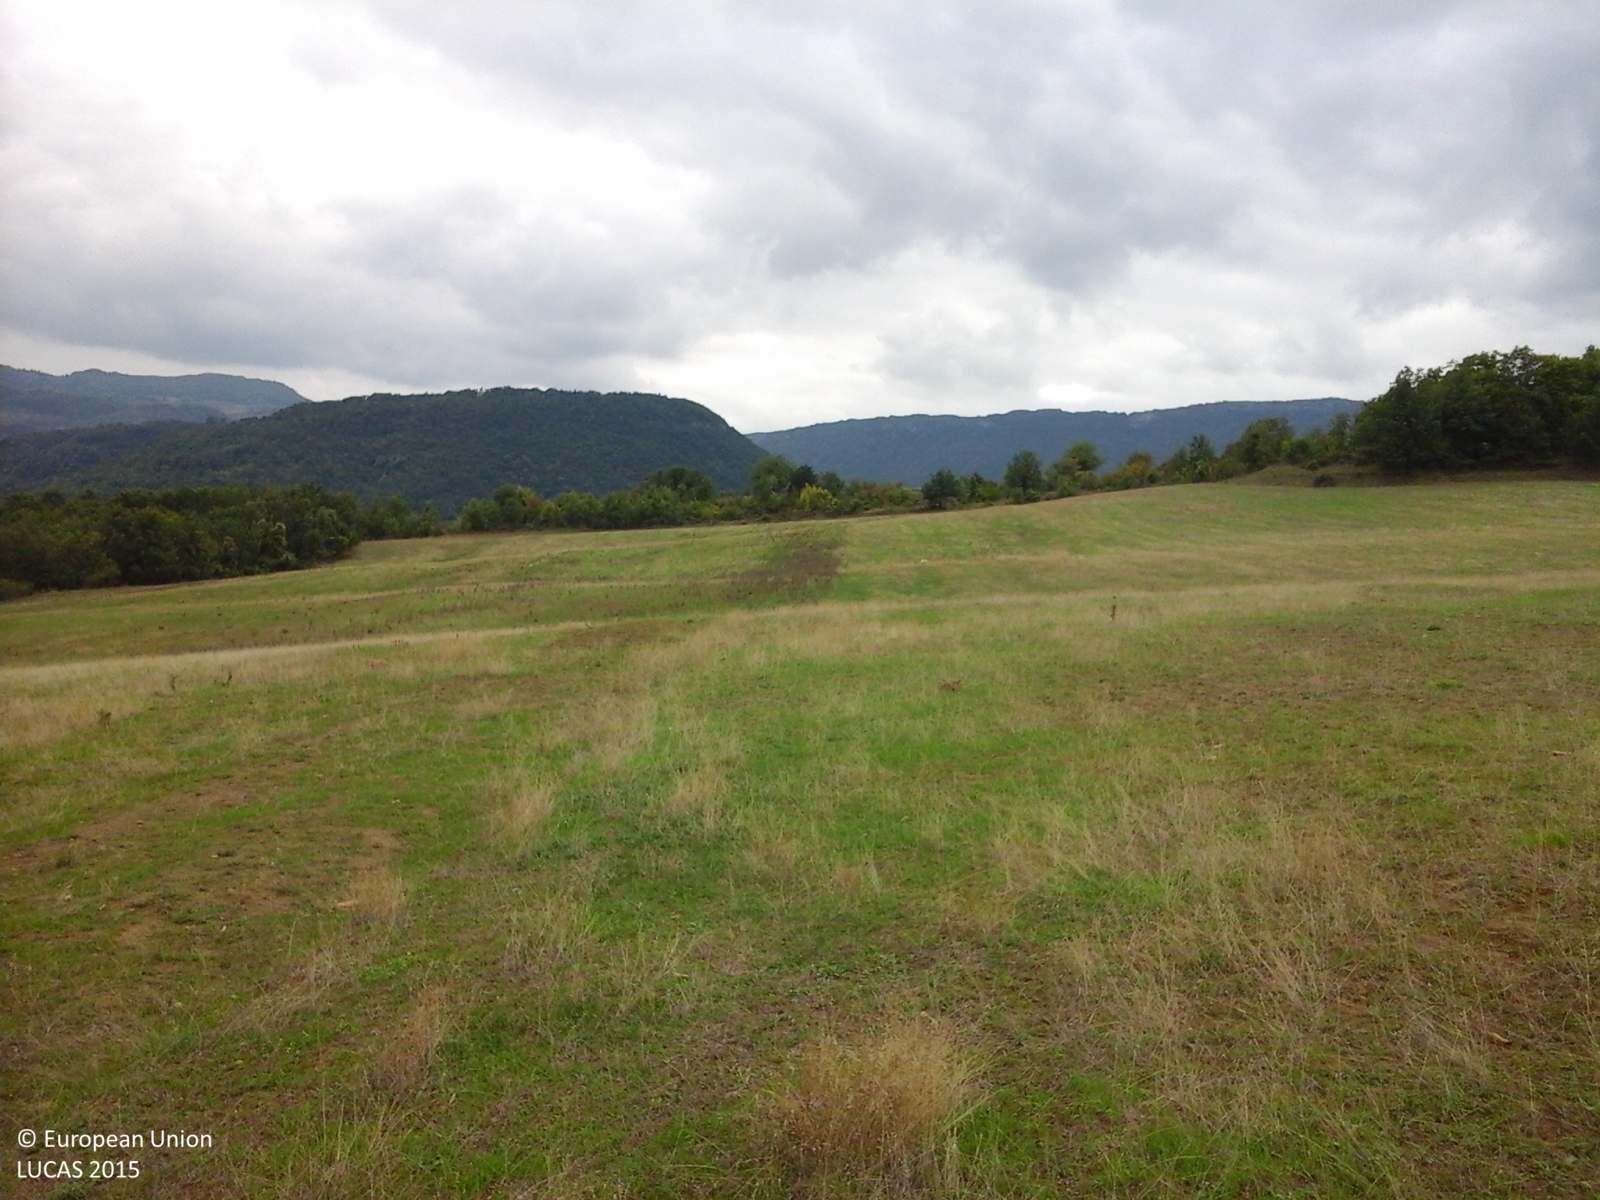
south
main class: Grassland
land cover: Spontaneously vegetated surfaces
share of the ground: > 75 %
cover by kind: herbaceous plants 75 %, unconsolidated bare surface 25 %
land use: Fallow land
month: October
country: GR
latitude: 40.3839
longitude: 21.0955
